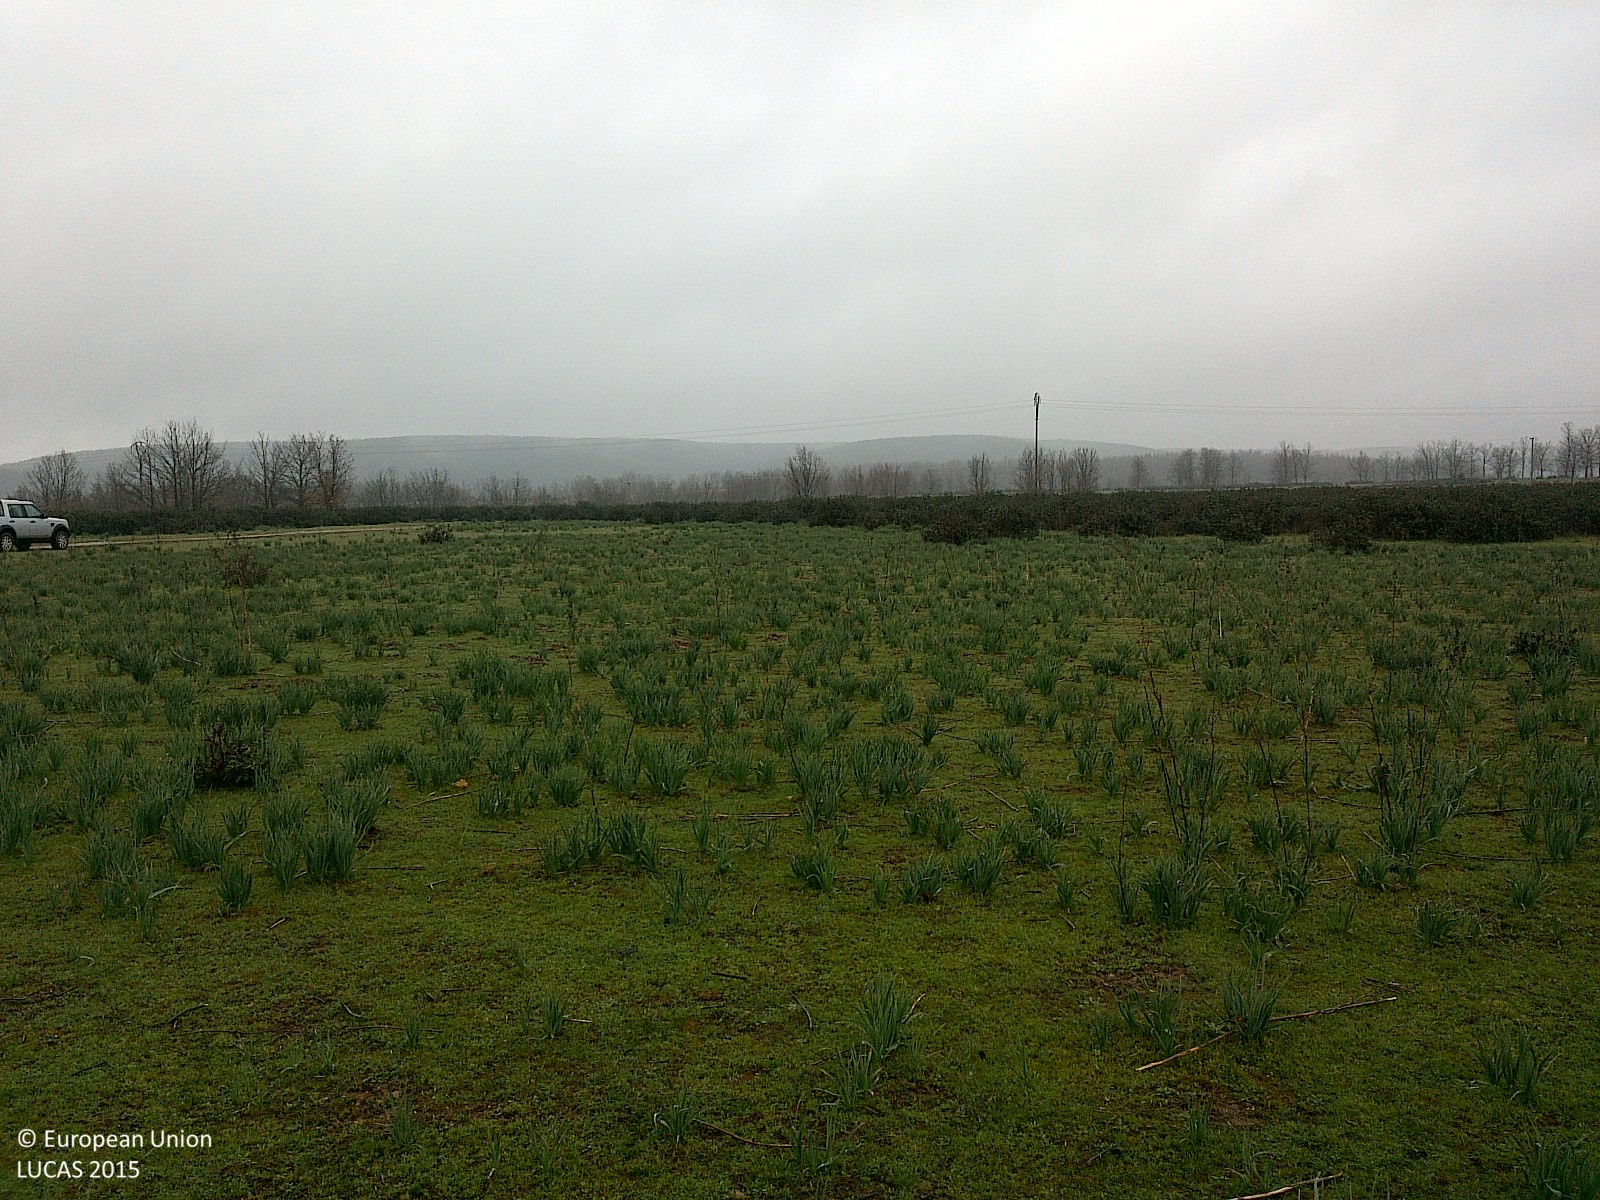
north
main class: Grassland
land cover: Grassland without tree/shrub cover
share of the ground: > 75 %
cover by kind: herbaceous plants 100 %
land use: Agriculture (excluding fallow land and kitchen gardens)
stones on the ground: < 10 %
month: April
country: ES
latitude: 42.0284
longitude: -3.3010
